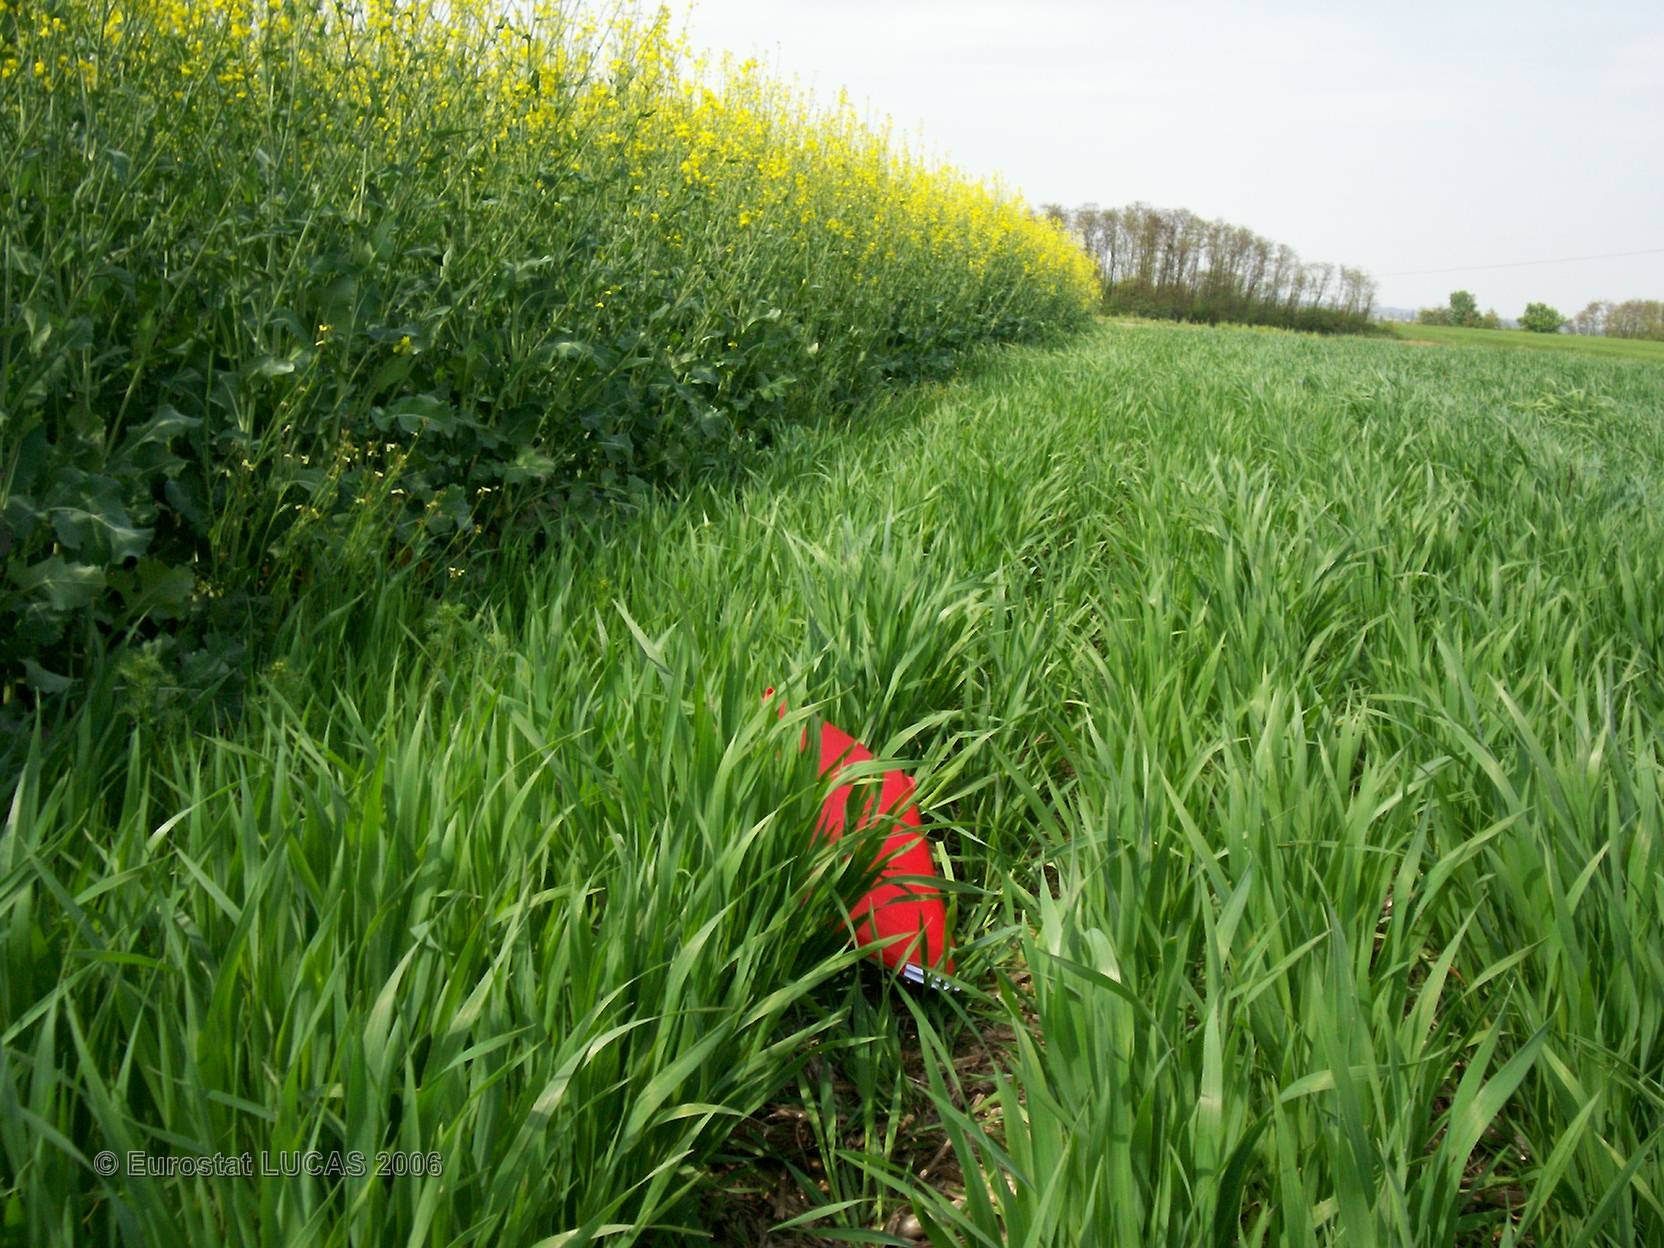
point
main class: Cropland
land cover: Oats
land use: Agriculture (excluding fallow land and kitchen gardens)
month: May
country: FR
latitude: 46.0068
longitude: 4.7727
